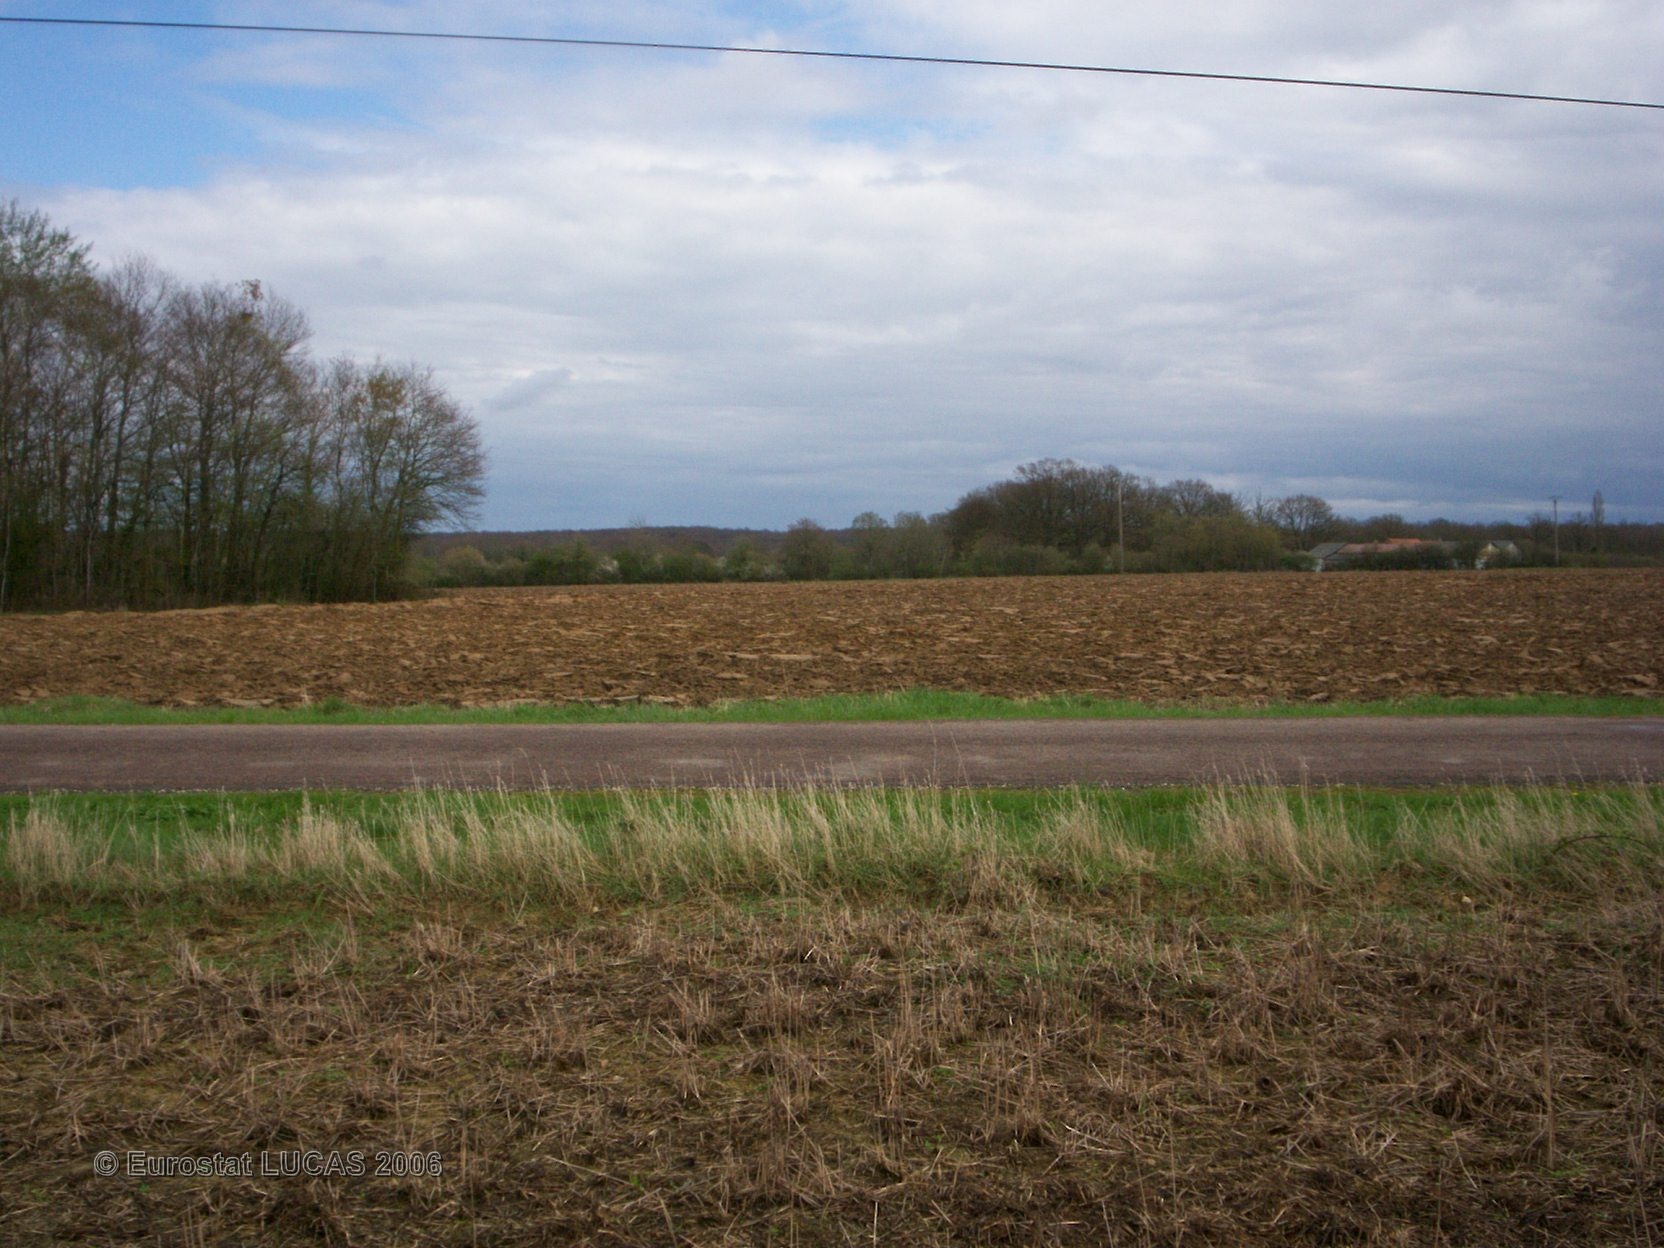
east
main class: Cropland
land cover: Other leguminous and mixtures for fodder
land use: Agriculture (excluding fallow land and kitchen gardens)
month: May
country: FR
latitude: 47.4772
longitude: 3.0013
